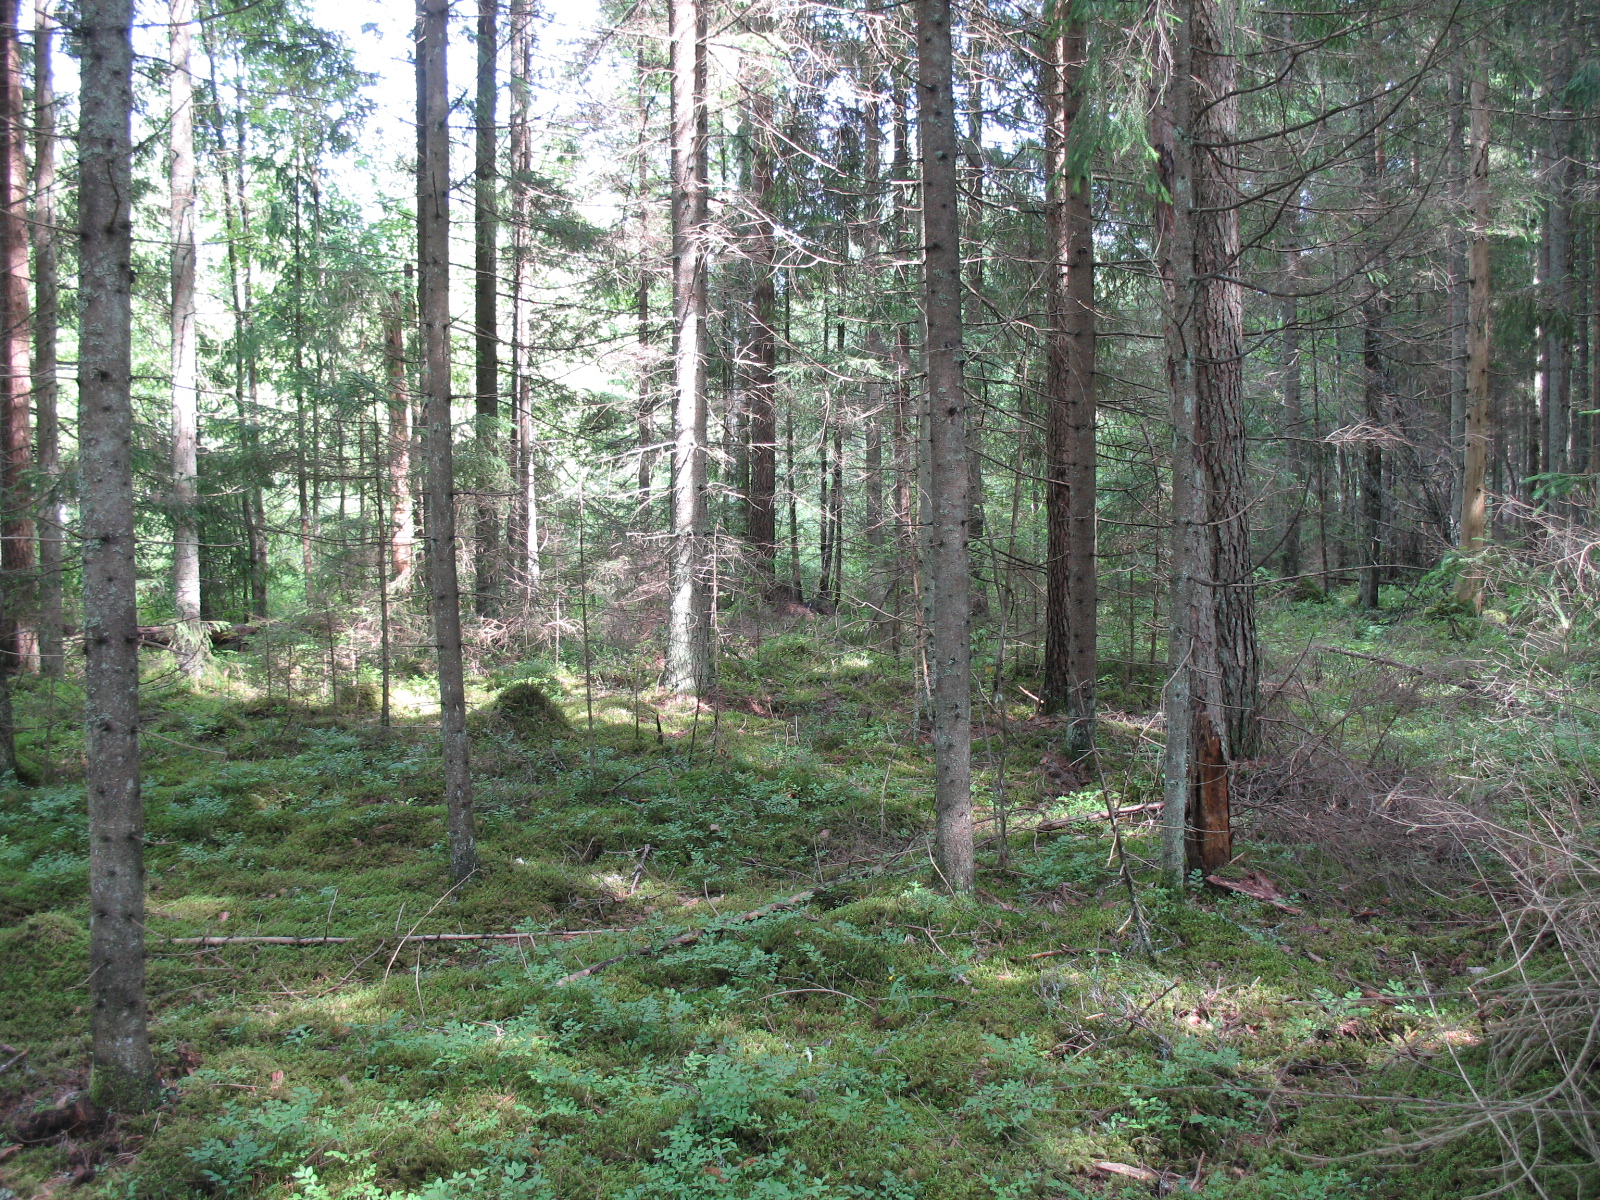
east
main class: Woodland
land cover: Other coniferous woodland
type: hemiboreal forest and nemoral coniferous forest and mixed broadleaved-coniferous forest
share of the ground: > 75 %
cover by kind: coniferous forest trees 85 %, lichens and mosses 10 %, herbaceous plants 5 %
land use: Forestry
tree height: > 5 m
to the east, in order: Other coniferous woodland; Spruce dominated mixed woodland; Other mixed woodland; Spruce dominated mixed woodland; Spontaneously vegetated surfaces
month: July
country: LV
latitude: 56.5451
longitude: 25.1561
